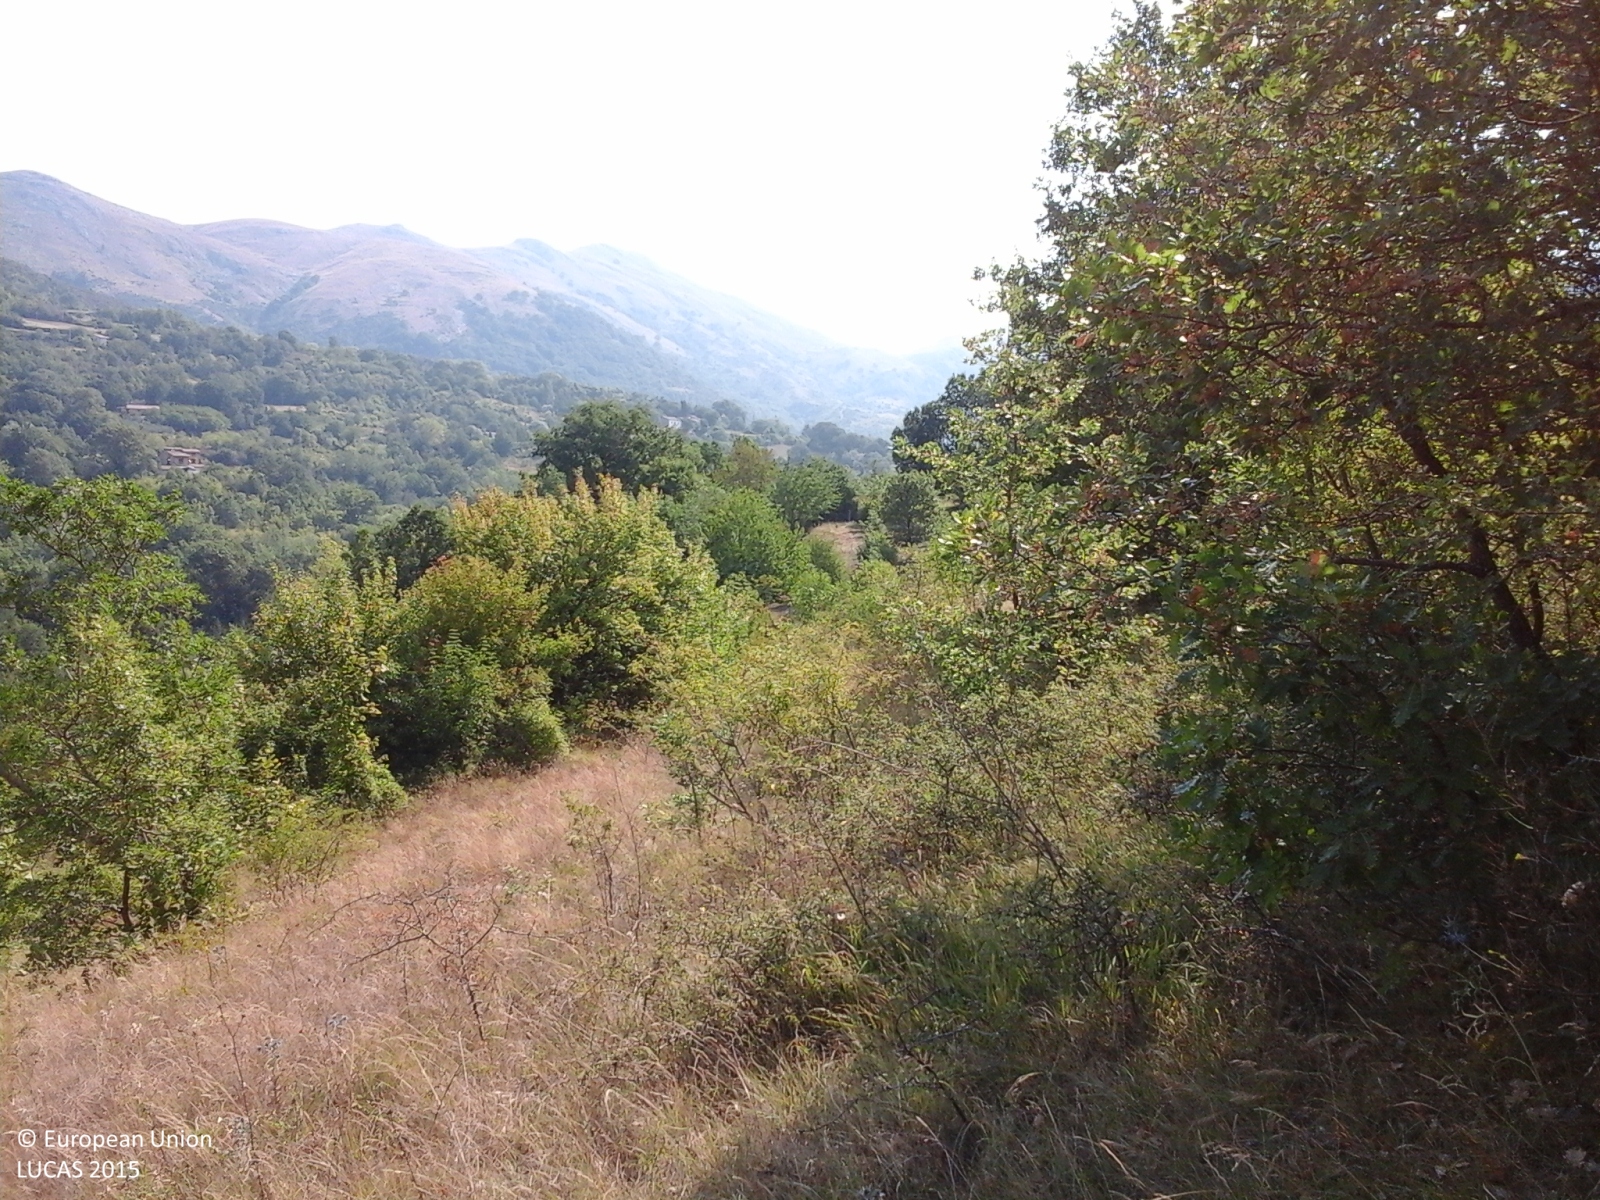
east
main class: Woodland
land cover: Broadleaved woodland
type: thermophilous deciduous forest
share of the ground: > 75 %
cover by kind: broadleaved forest trees 90 %, shrubs 5 %, herbaceous plants 5 %
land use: Semi-natural and natural areas not in use
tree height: > 5 m
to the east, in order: Broadleaved woodland
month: August
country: IT
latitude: 41.5140
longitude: 14.2860
